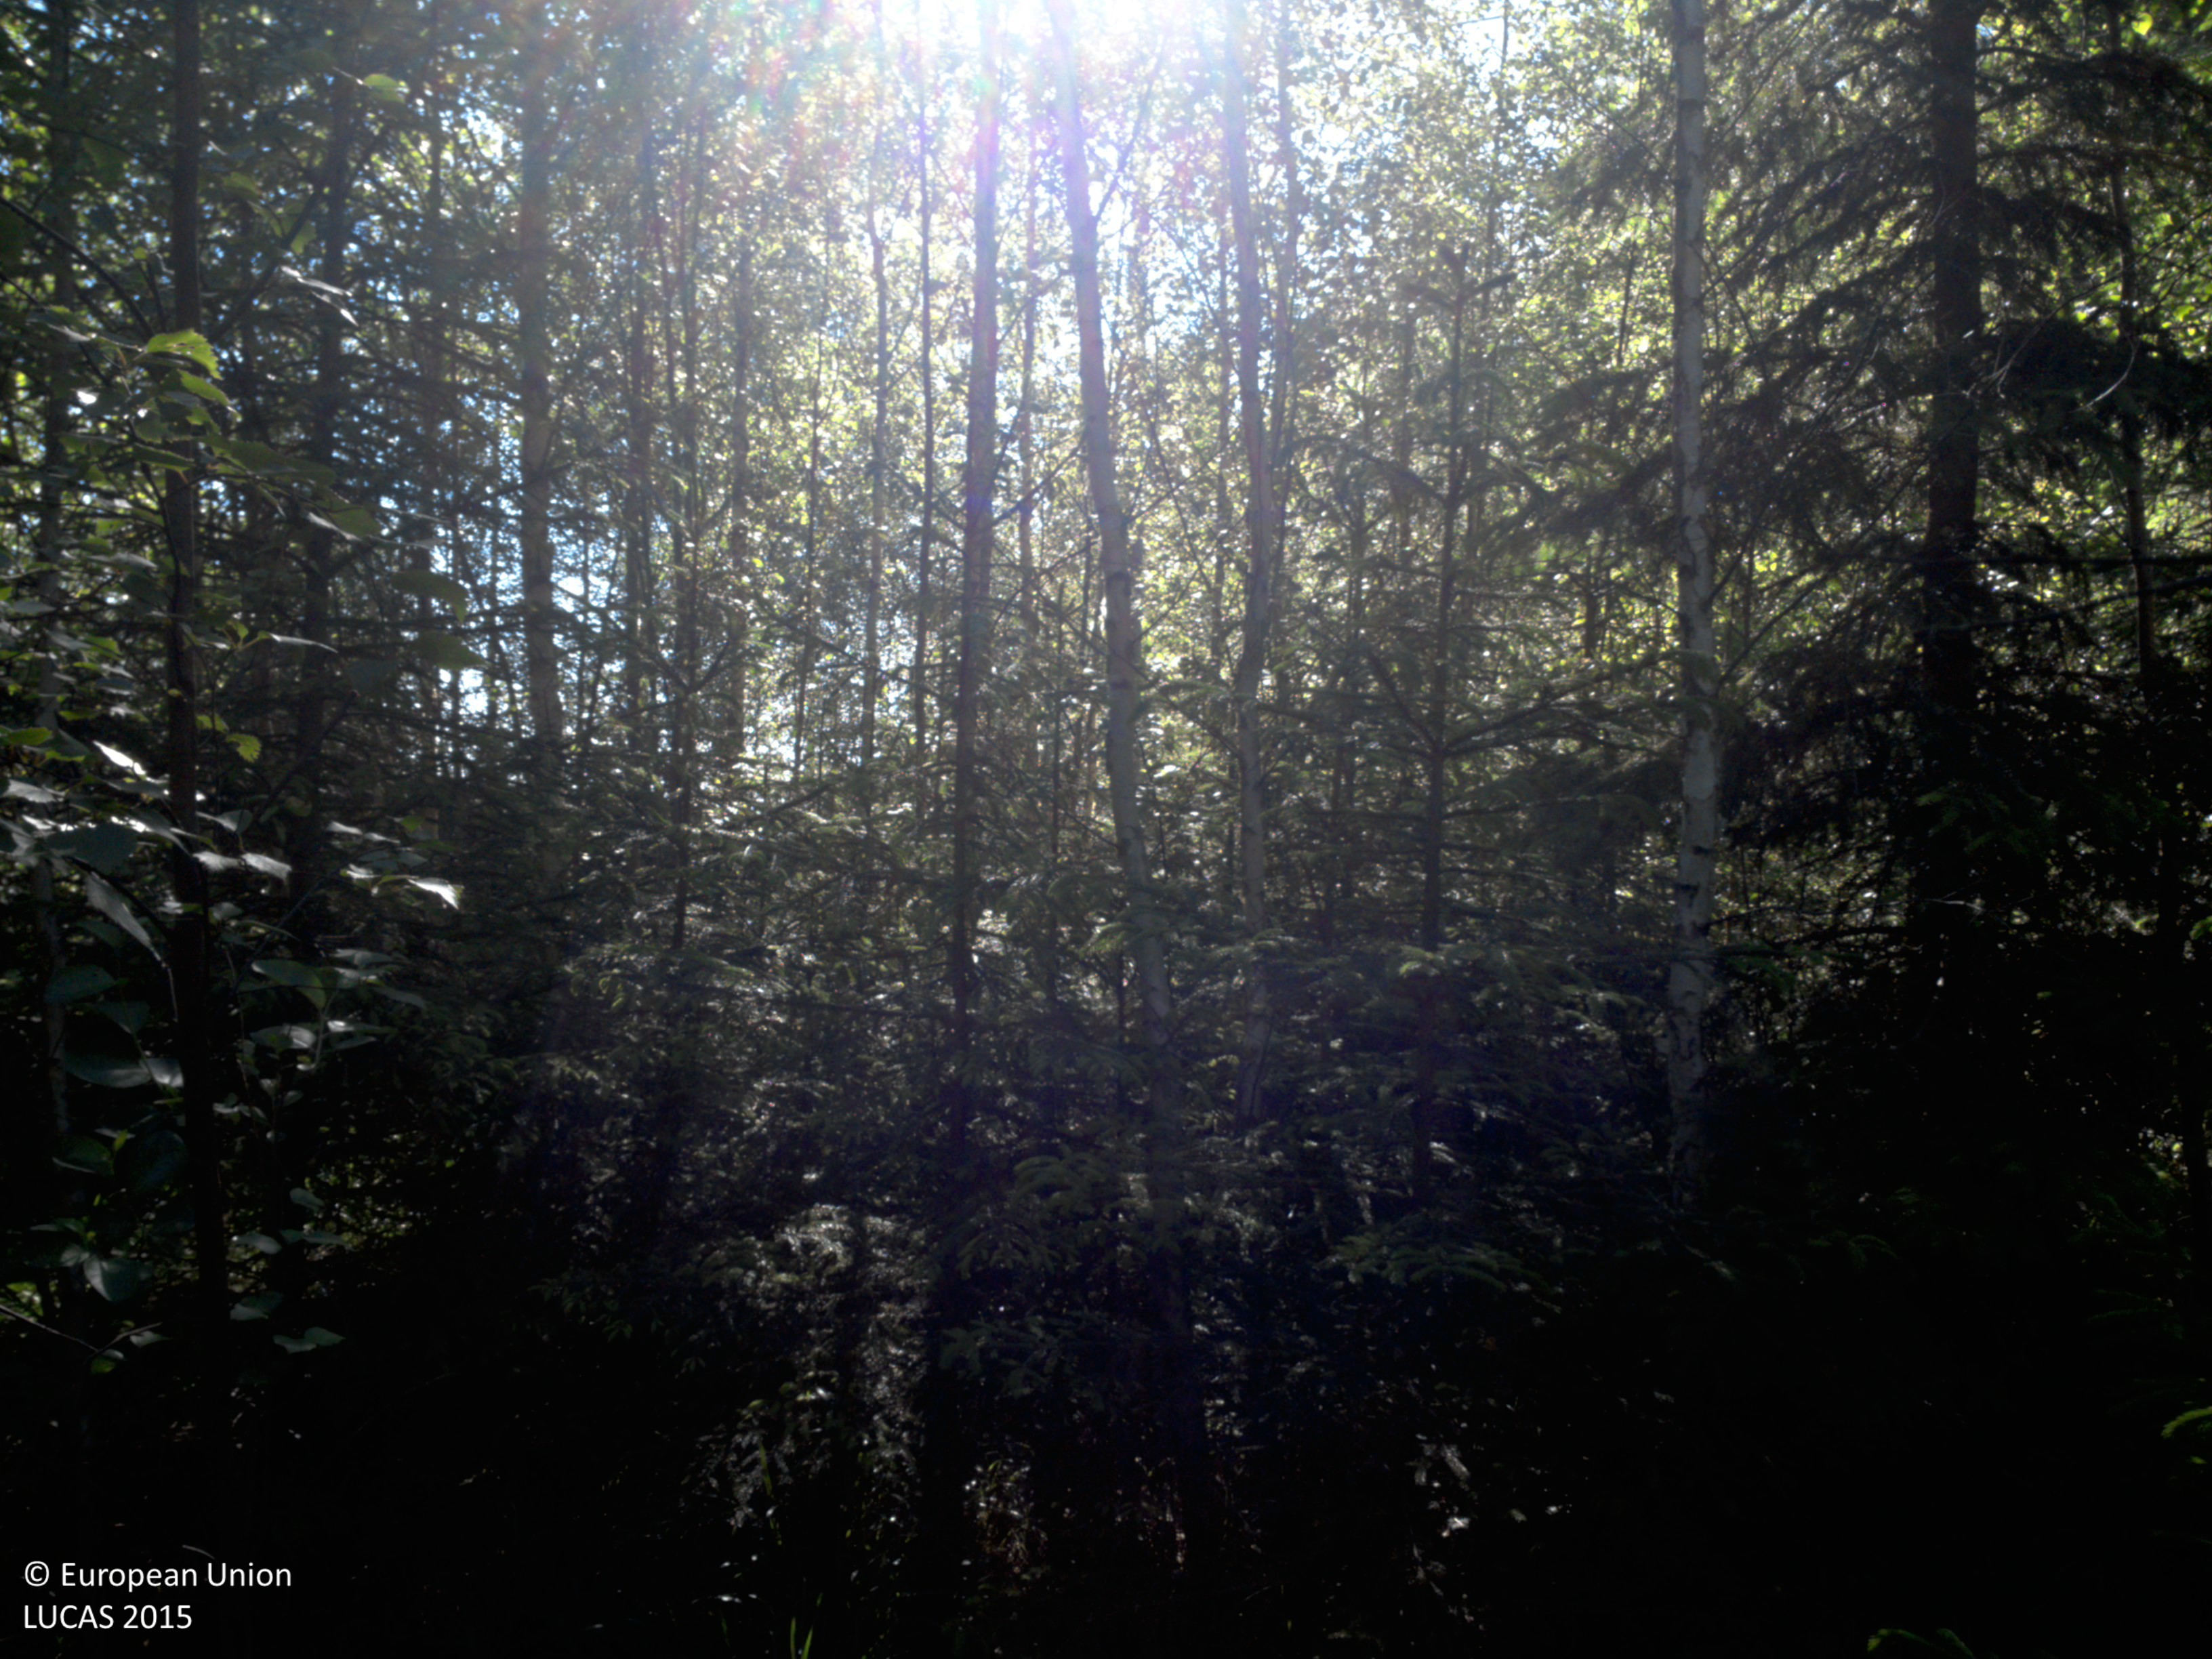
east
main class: Woodland
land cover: Broadleaved woodland
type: hemiboreal forest and nemoral coniferous forest and mixed broadleaved-coniferous forest
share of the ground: > 75 %
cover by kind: broadleaved forest trees 80 %, herbaceous plants 10 %, coniferous forest trees 5 %, shrubs 5 %
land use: Forestry
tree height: > 5 m
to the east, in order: Broadleaved woodland; Electric lines; Broadleaved woodland; Grassland with sparse tree/shrub cover; Artificial constructions in urban areas; Grassland with sparse tree/shrub cover; Broadleaved woodland; Spruce dominated coniferous woodland
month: June
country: SE
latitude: 59.2286
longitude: 12.1152
